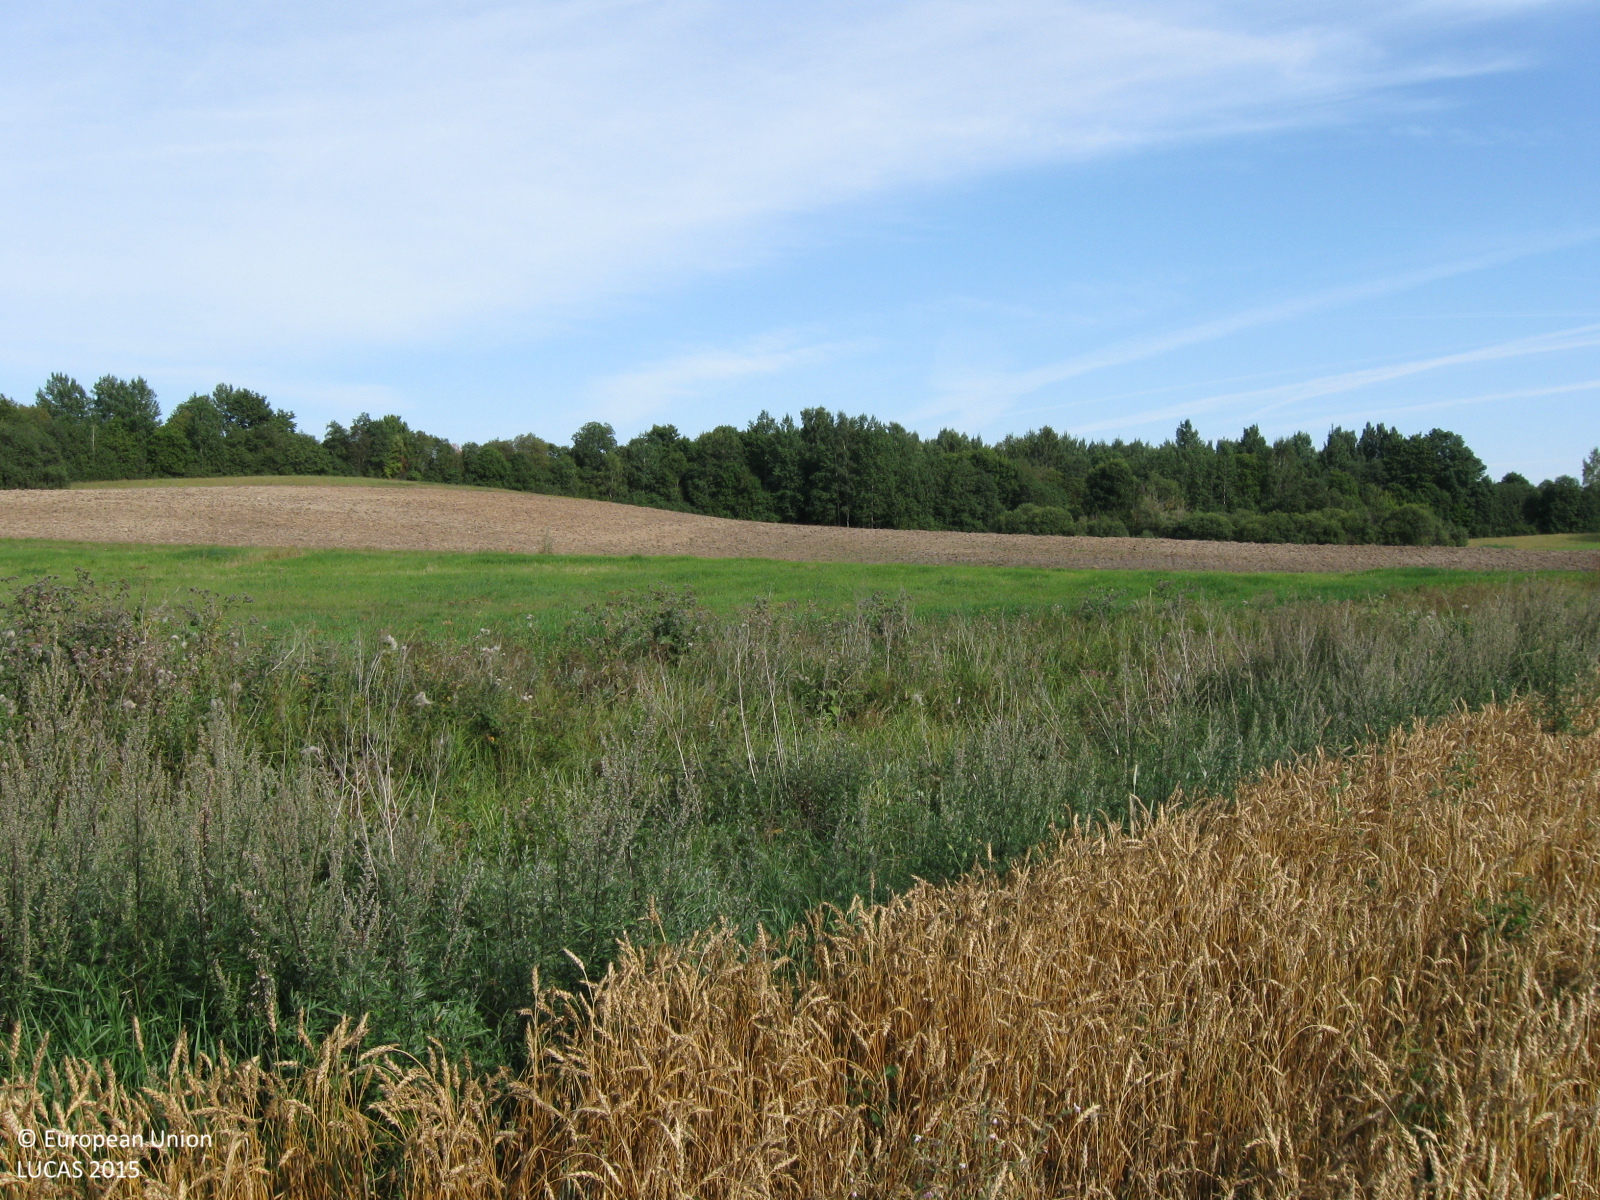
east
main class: Cropland
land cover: Common wheat
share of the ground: > 75 %
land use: Agriculture (excluding fallow land and kitchen gardens)
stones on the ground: < 10 %
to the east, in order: Common wheat; Spontaneously vegetated surfaces; Ditches and canals; Spontaneously vegetated surfaces; Grassland without tree/shrub cover; Tracks; Grass margins; Other bare soil; Grassland without tree/shrub cover
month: August
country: LT
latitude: 55.4956
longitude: 22.5509
